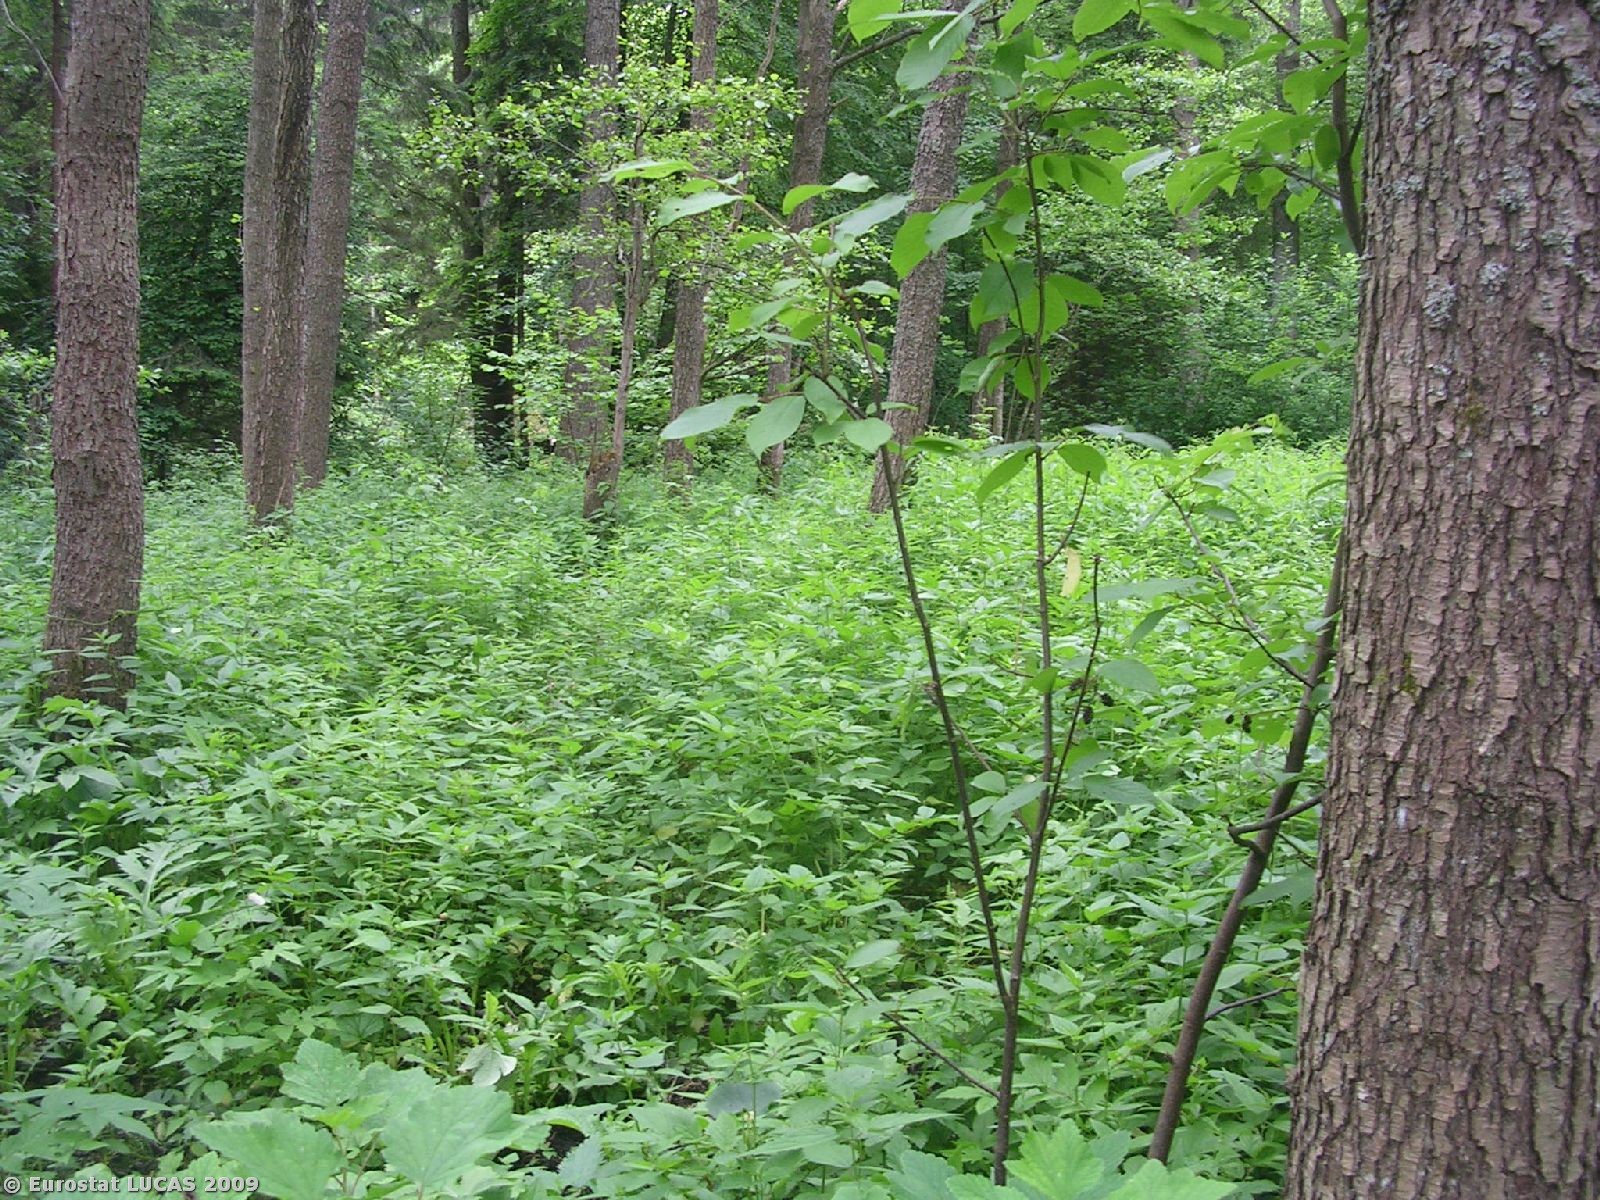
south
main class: Woodland
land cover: Mixed woodland
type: hemiboreal forest and nemoral coniferous forest and mixed broadleaved-coniferous forest
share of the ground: 50 - 75 %
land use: Forestry
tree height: > 5 m
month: June
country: PL
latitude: 53.3936
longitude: 23.2981
